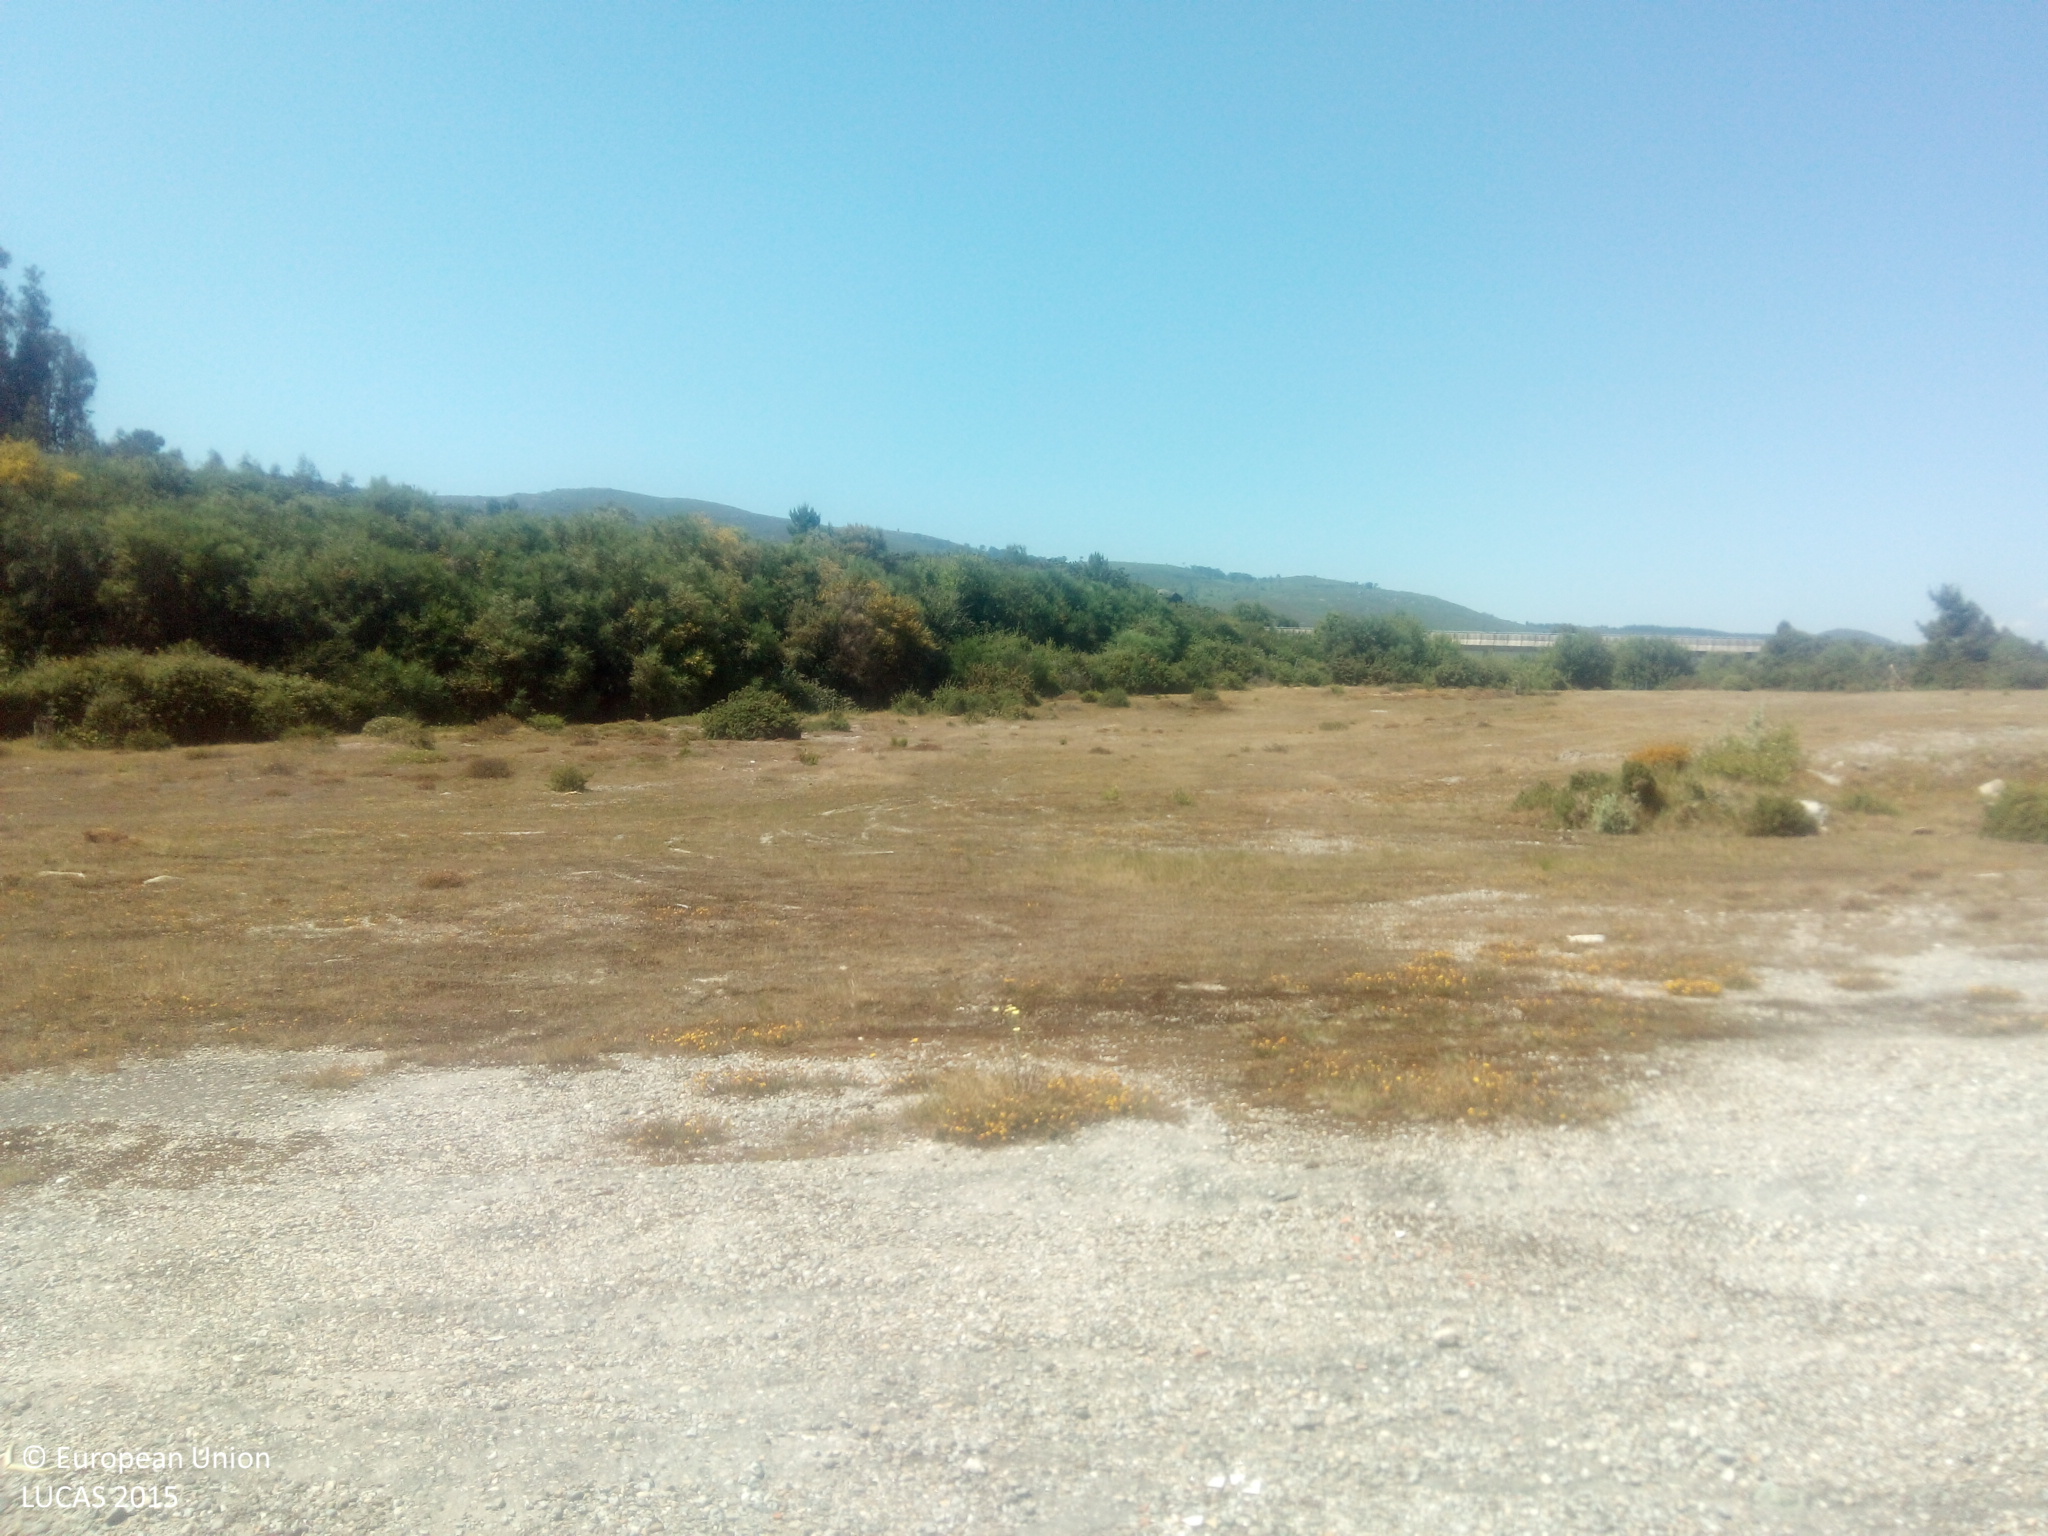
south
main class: Shrubland
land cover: Shrubland without tree cover
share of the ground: > 75 %
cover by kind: shrubs 70 %, consolidated bare surface 30 %
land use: Semi-natural and natural areas not in use
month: June
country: ES
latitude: 42.1869
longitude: -8.3110
